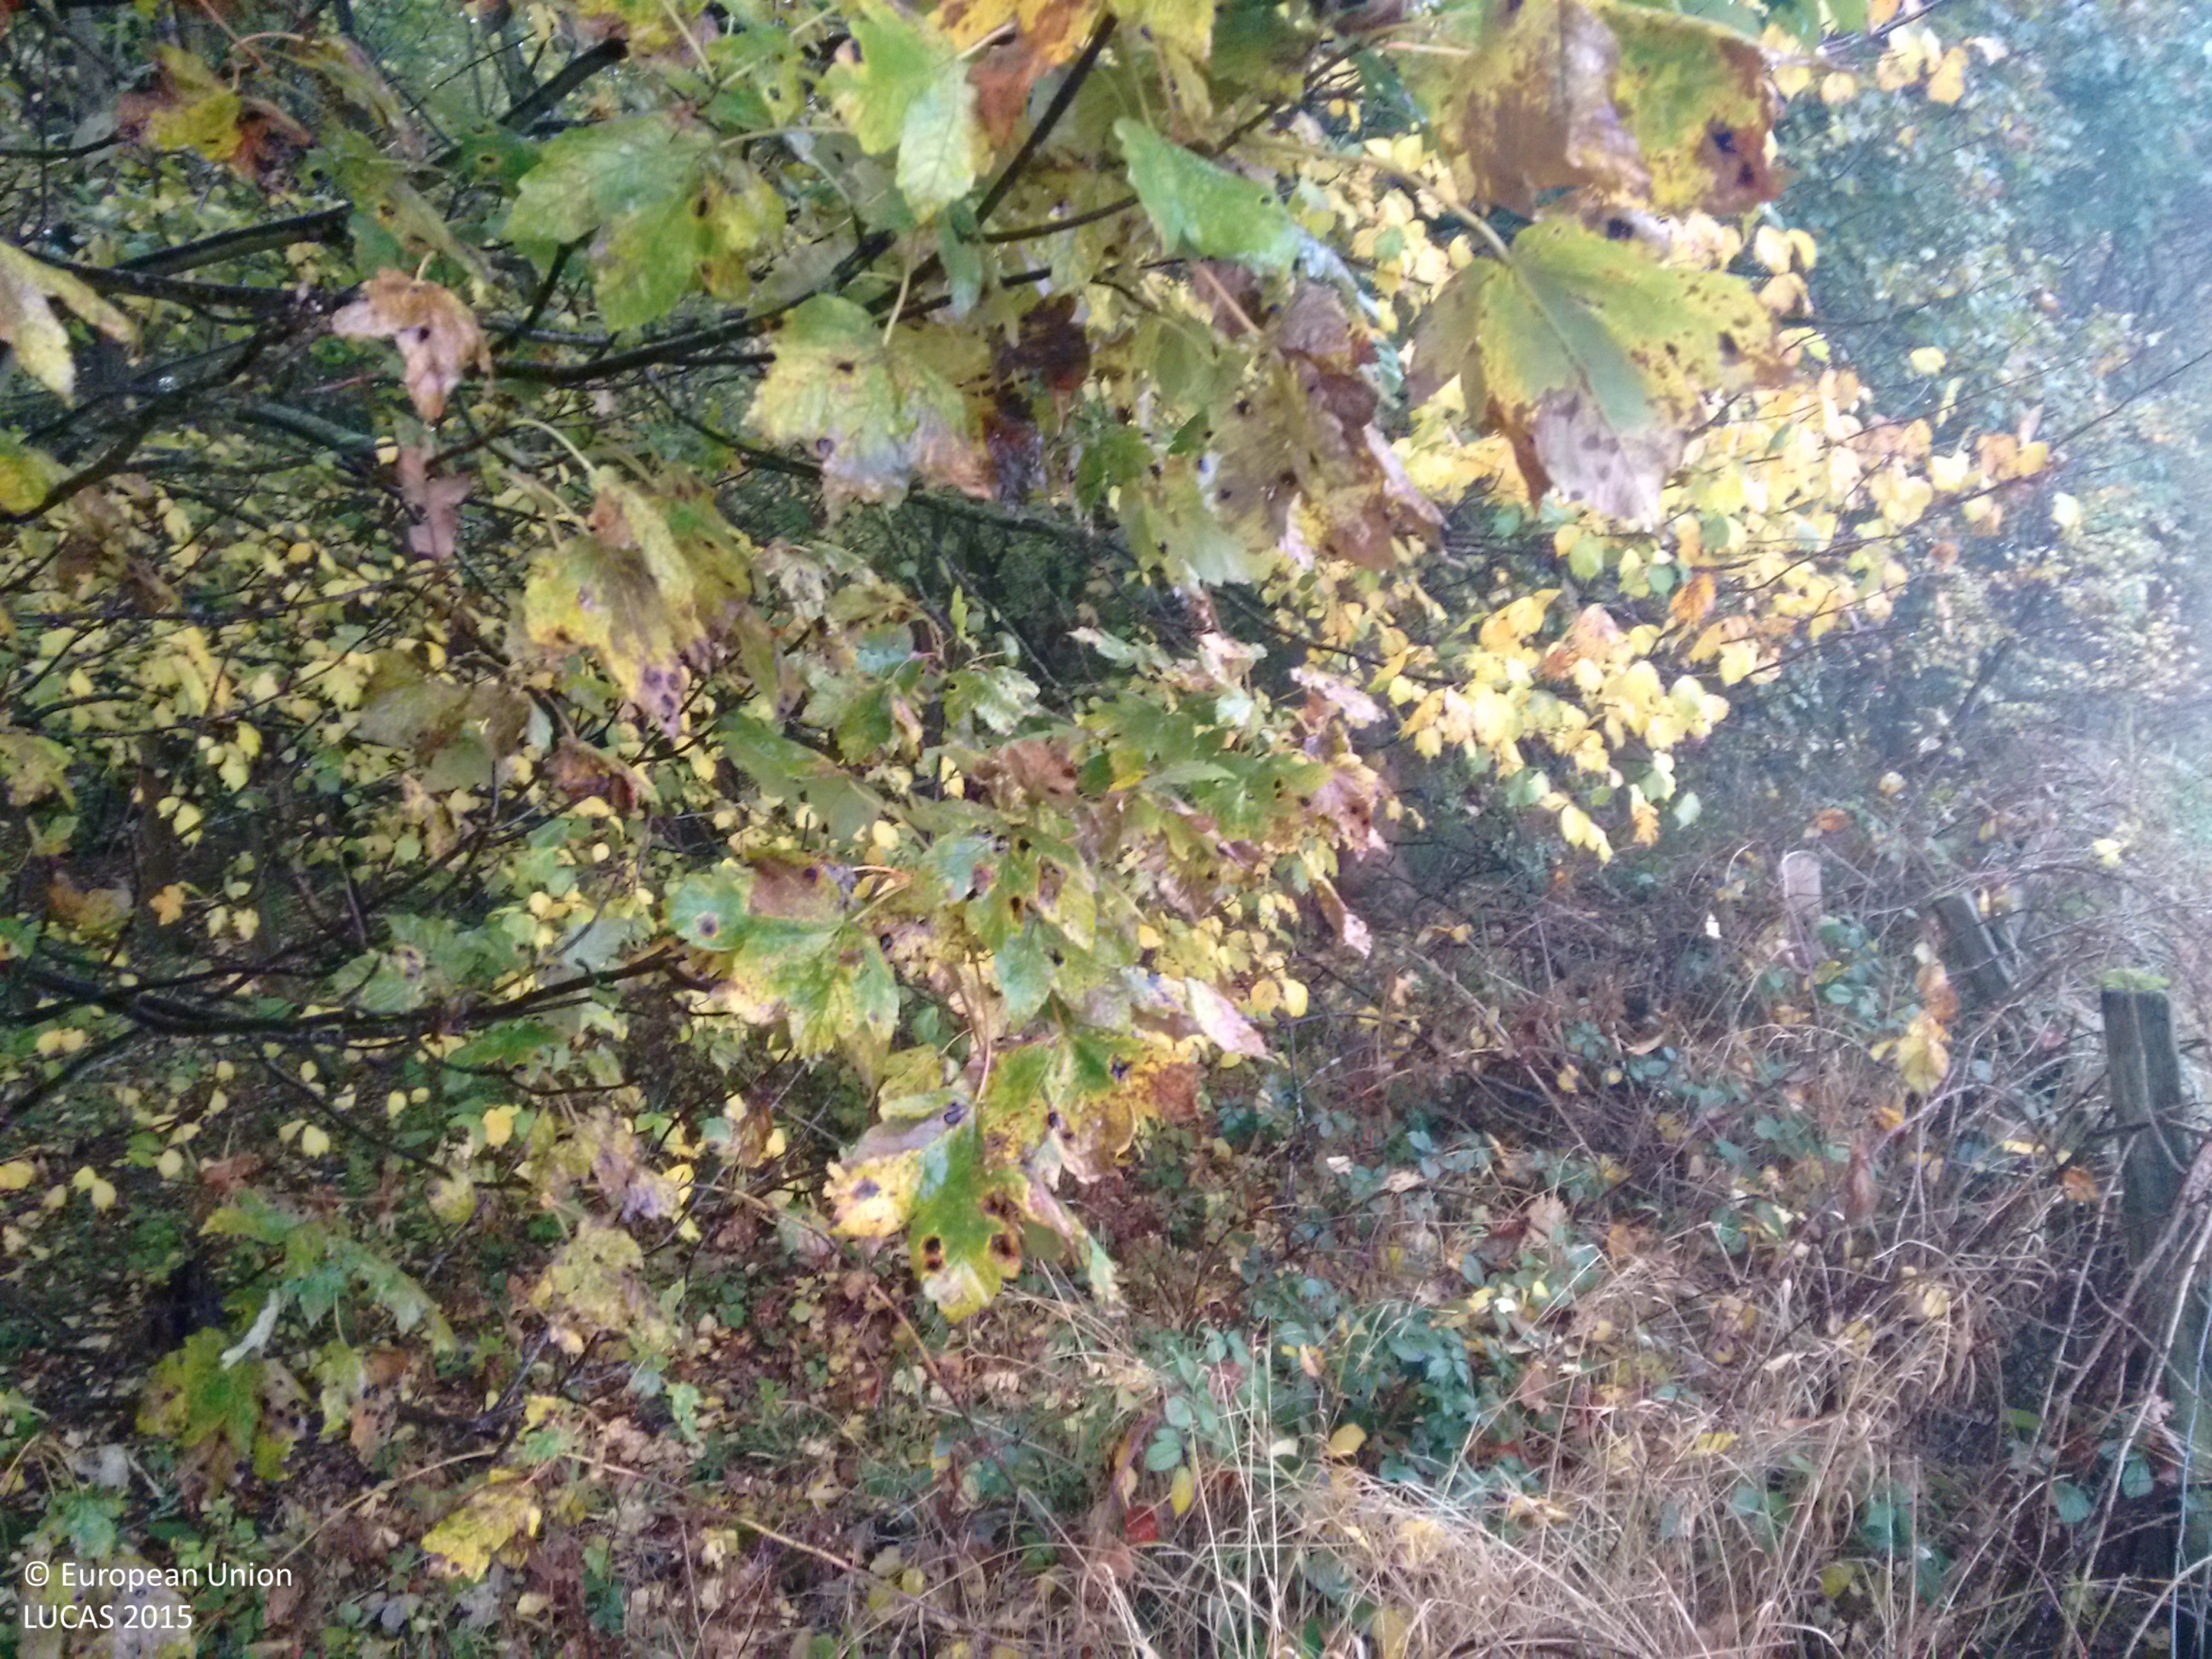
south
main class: Cropland
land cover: Common wheat
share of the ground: < 10 %
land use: Agriculture (excluding fallow land and kitchen gardens)
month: October
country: GB
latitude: 54.5324
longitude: -1.4055
